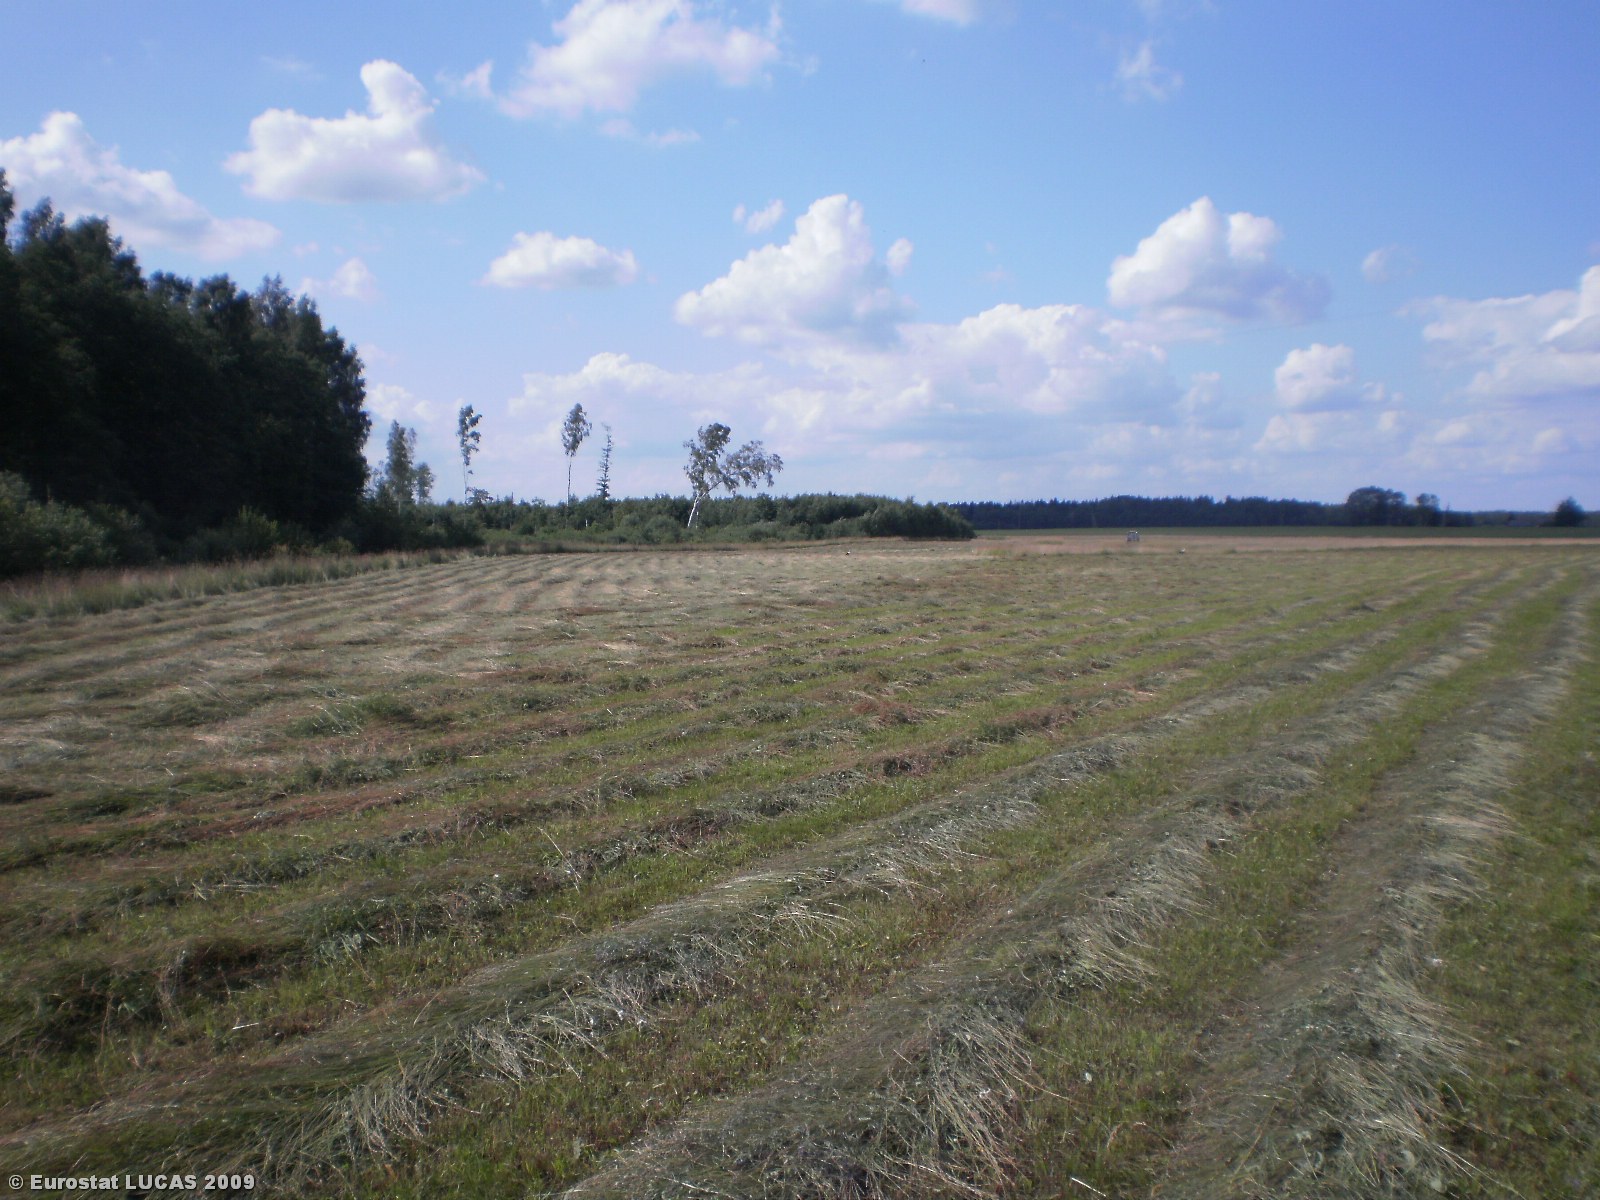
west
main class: Grassland
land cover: Grassland without tree/shrub cover
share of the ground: > 75 %
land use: Agriculture (excluding fallow land and kitchen gardens)
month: July
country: LT
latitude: 56.1273
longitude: 25.1221
